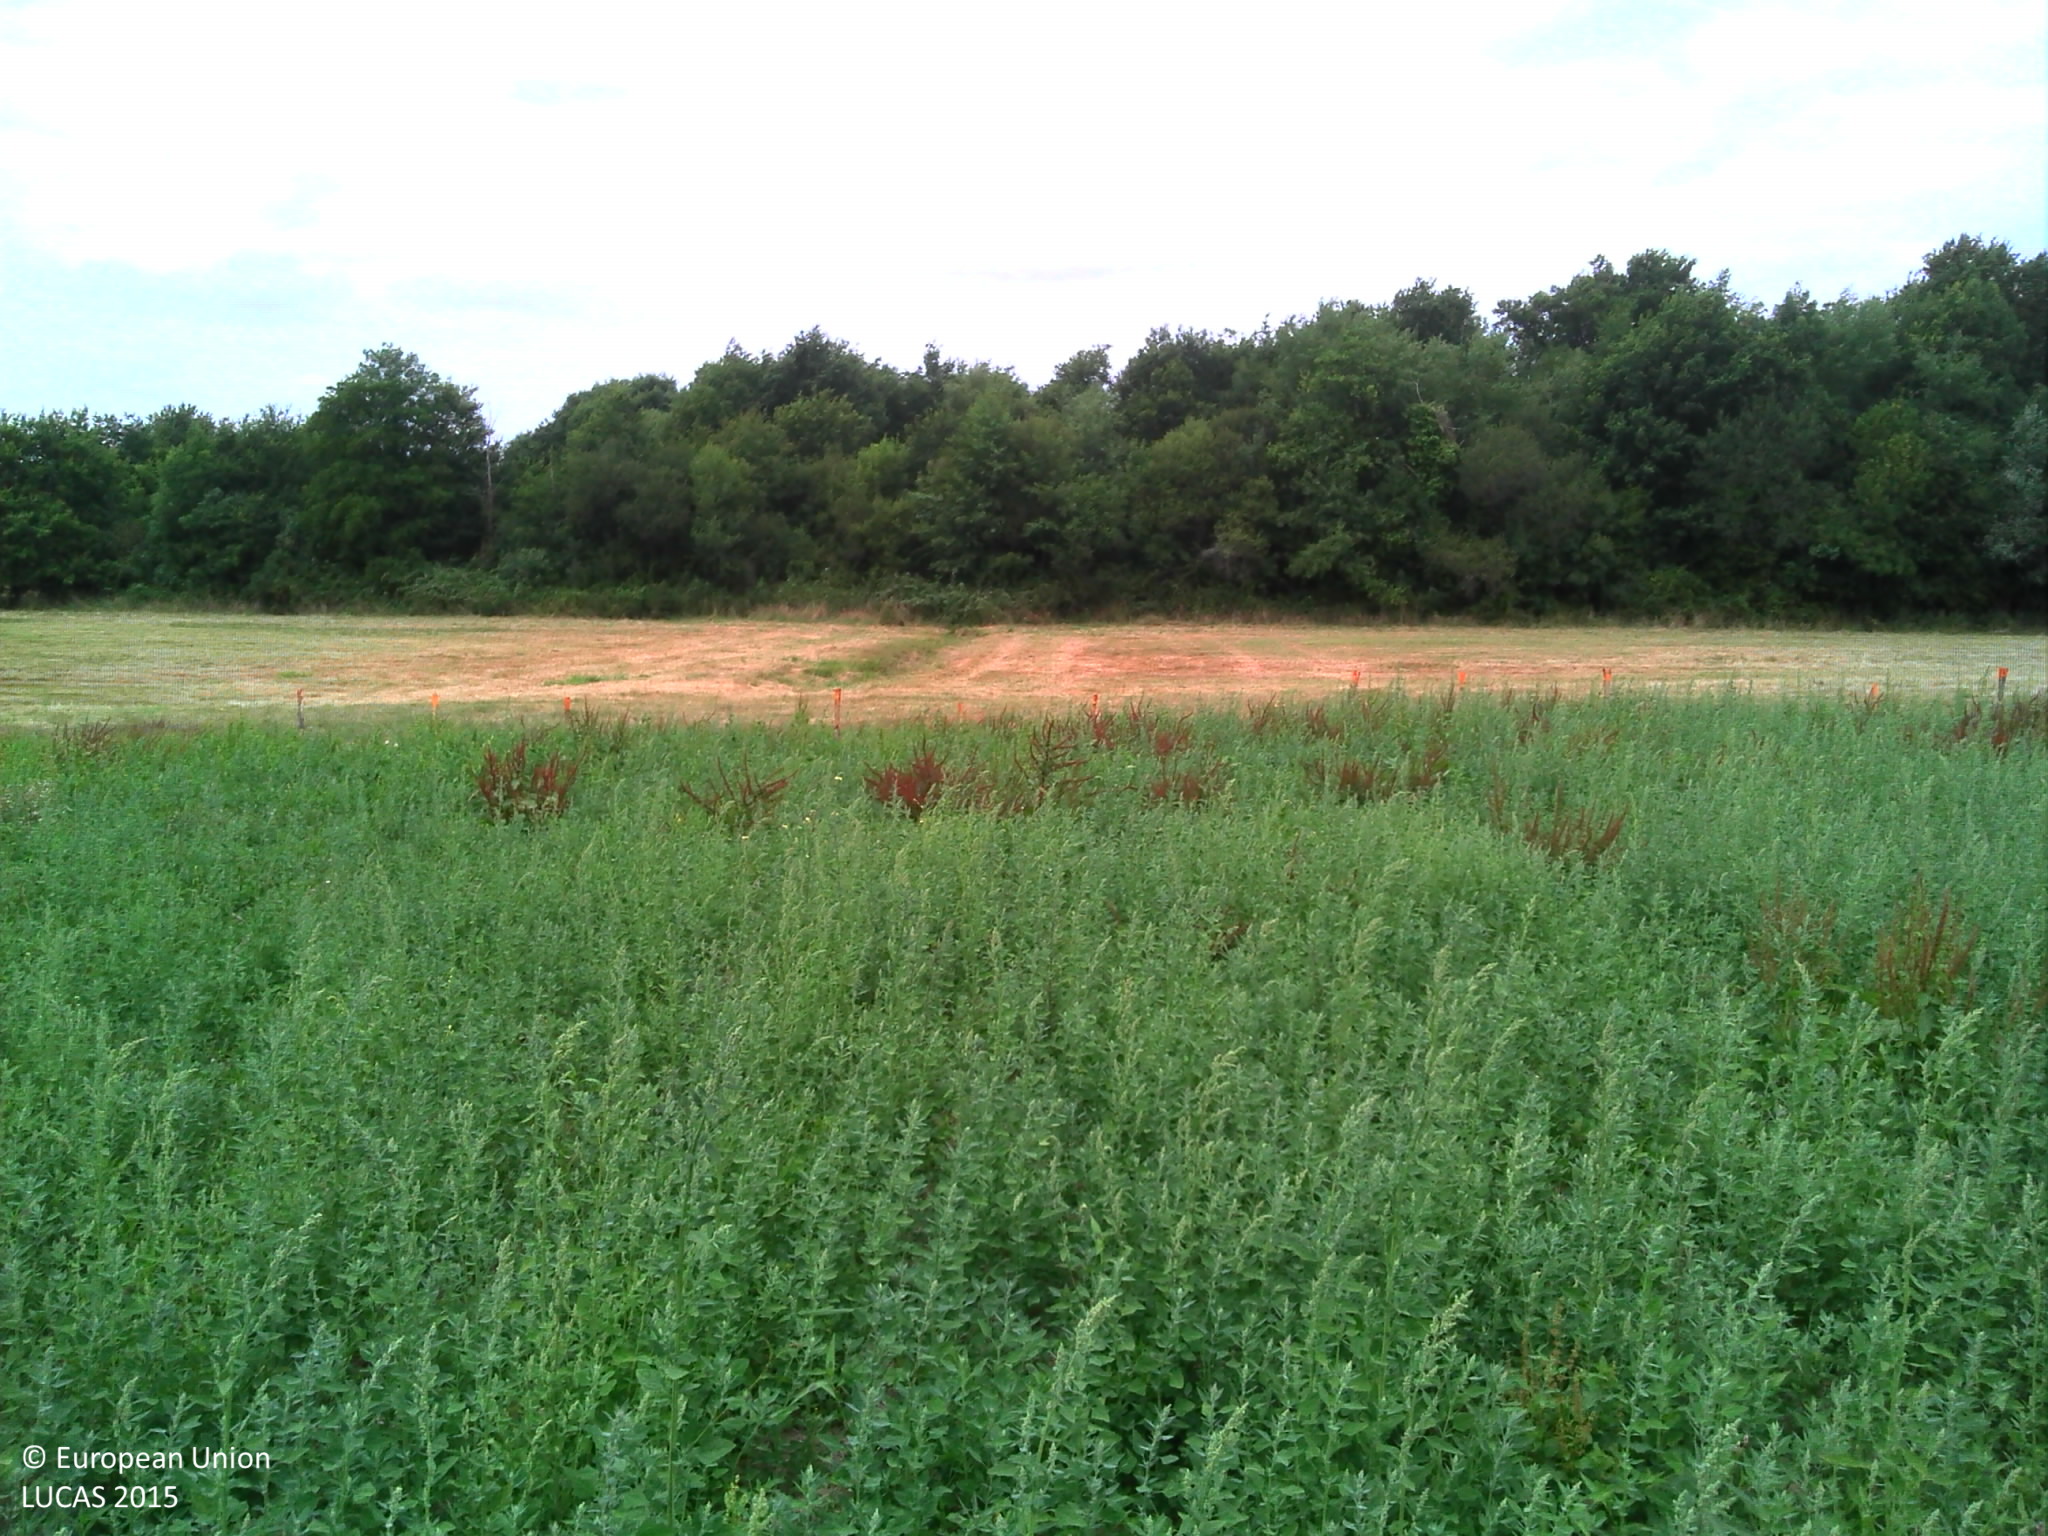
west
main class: Grassland
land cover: Spontaneously vegetated surfaces
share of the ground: > 75 %
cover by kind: herbaceous plants 100 %
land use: Fallow land
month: July
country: FR
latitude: 47.5153
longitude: -2.1221
